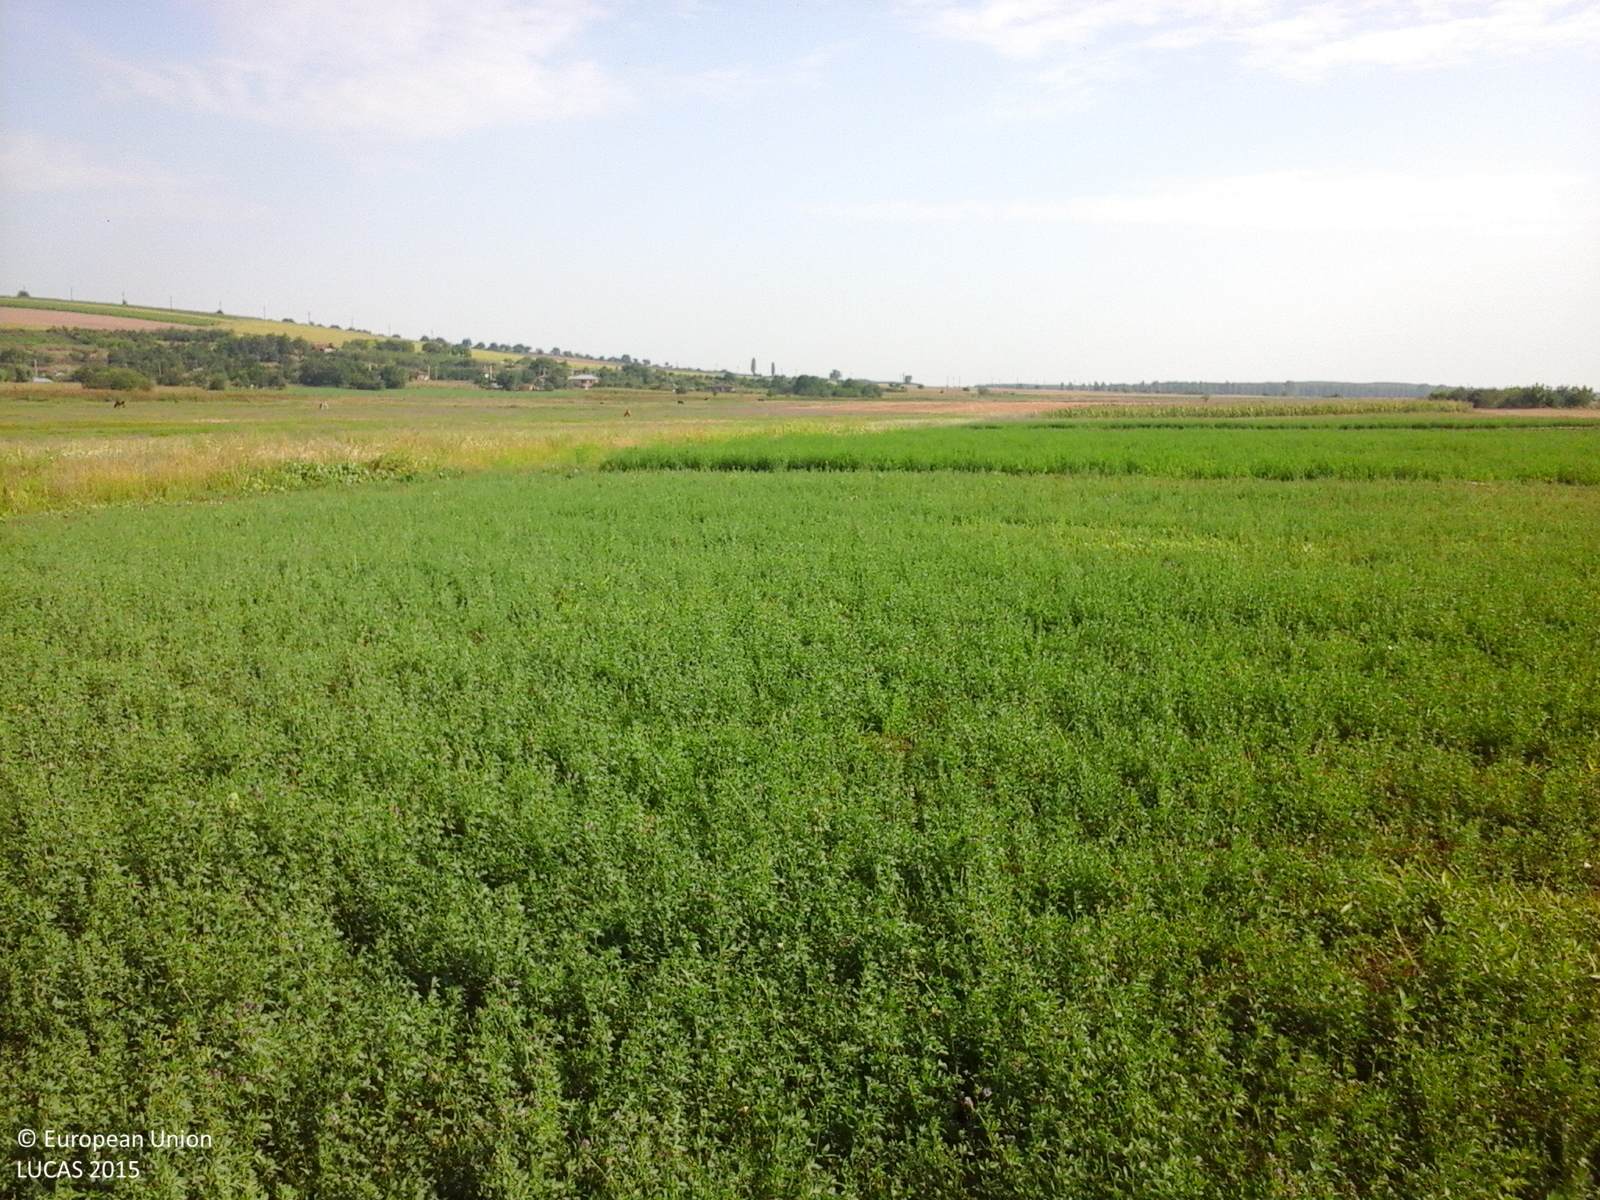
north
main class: Cropland
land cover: Lucerne
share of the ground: > 75 %
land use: Agriculture (excluding fallow land and kitchen gardens)
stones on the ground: < 10 %
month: August
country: RO
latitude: 44.0945
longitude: 27.4361
